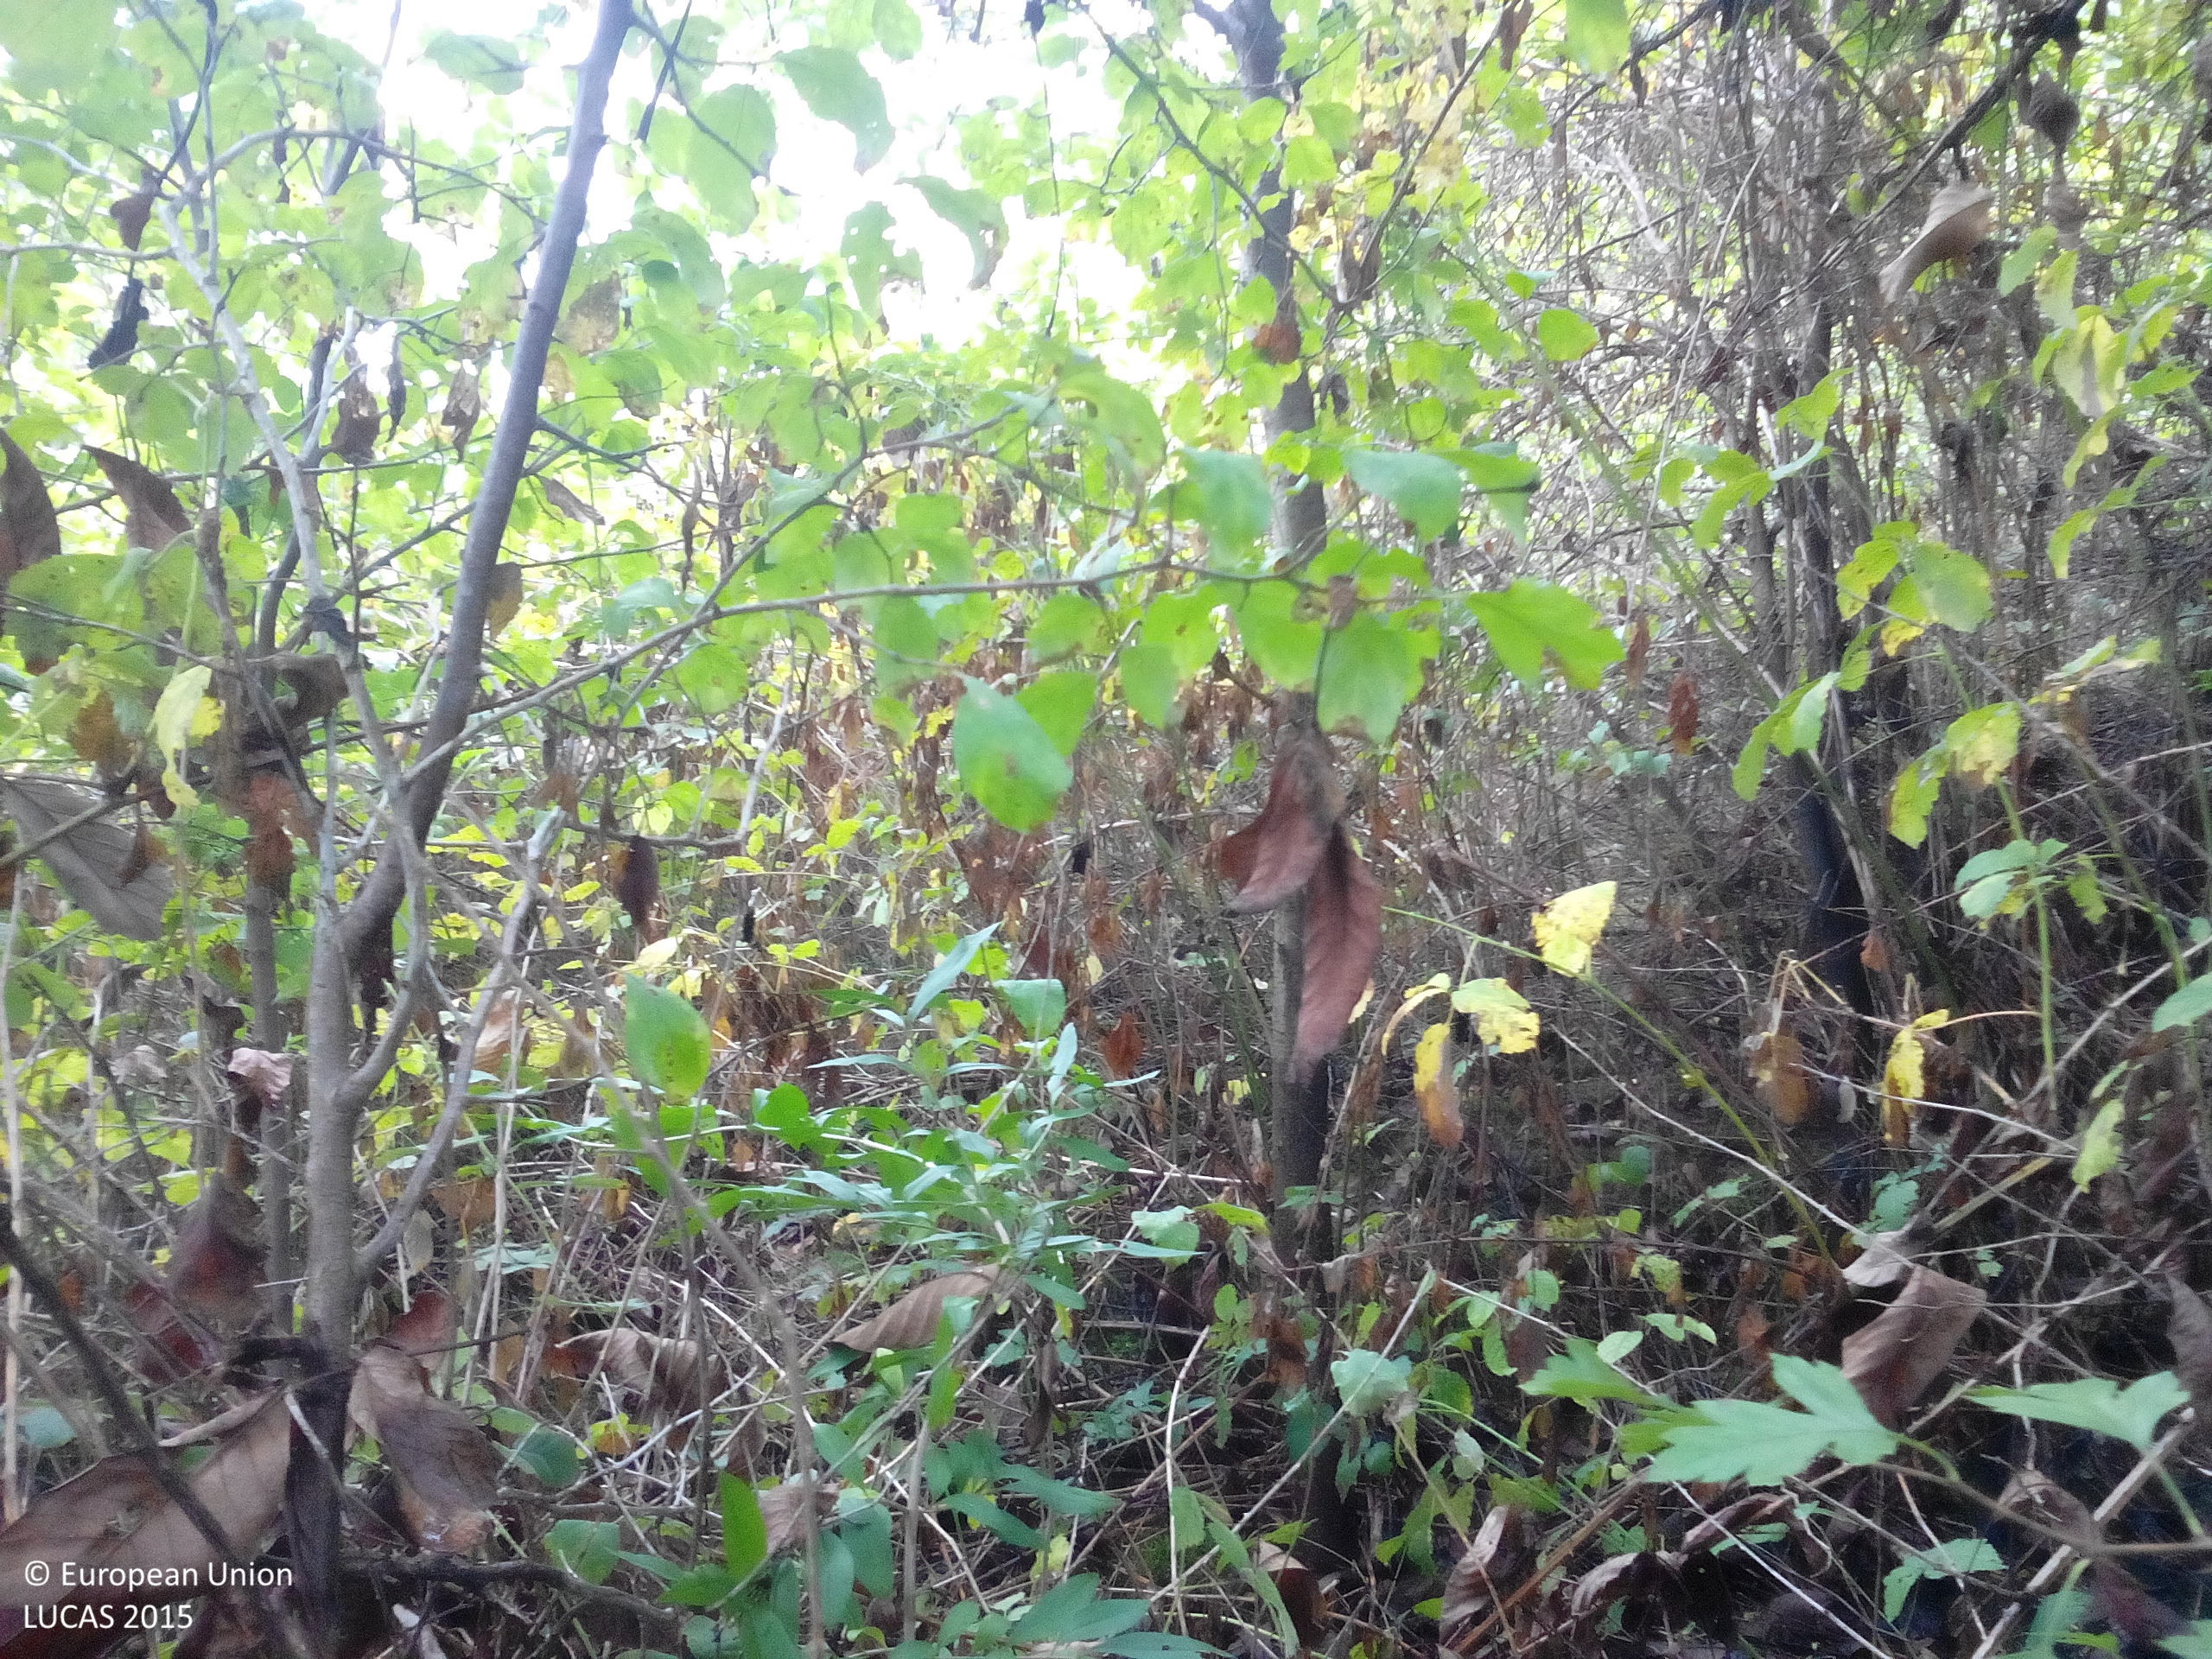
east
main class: Woodland
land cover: Broadleaved woodland
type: mesophytic deciduous forest
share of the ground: > 75 %
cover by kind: broadleaved forest trees 90 %, shrubs 5 %, herbaceous plants 5 %
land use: Semi-natural and natural areas not in use
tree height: > 5 m
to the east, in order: Broadleaved woodland; Grassland without tree/shrub cover; Other fruit trees and berries; Maize; Grassland without tree/shrub cover; Other fruit trees and berries; Grassland without tree/shrub cover
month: October
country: BG
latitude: 43.1218
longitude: 23.9994
